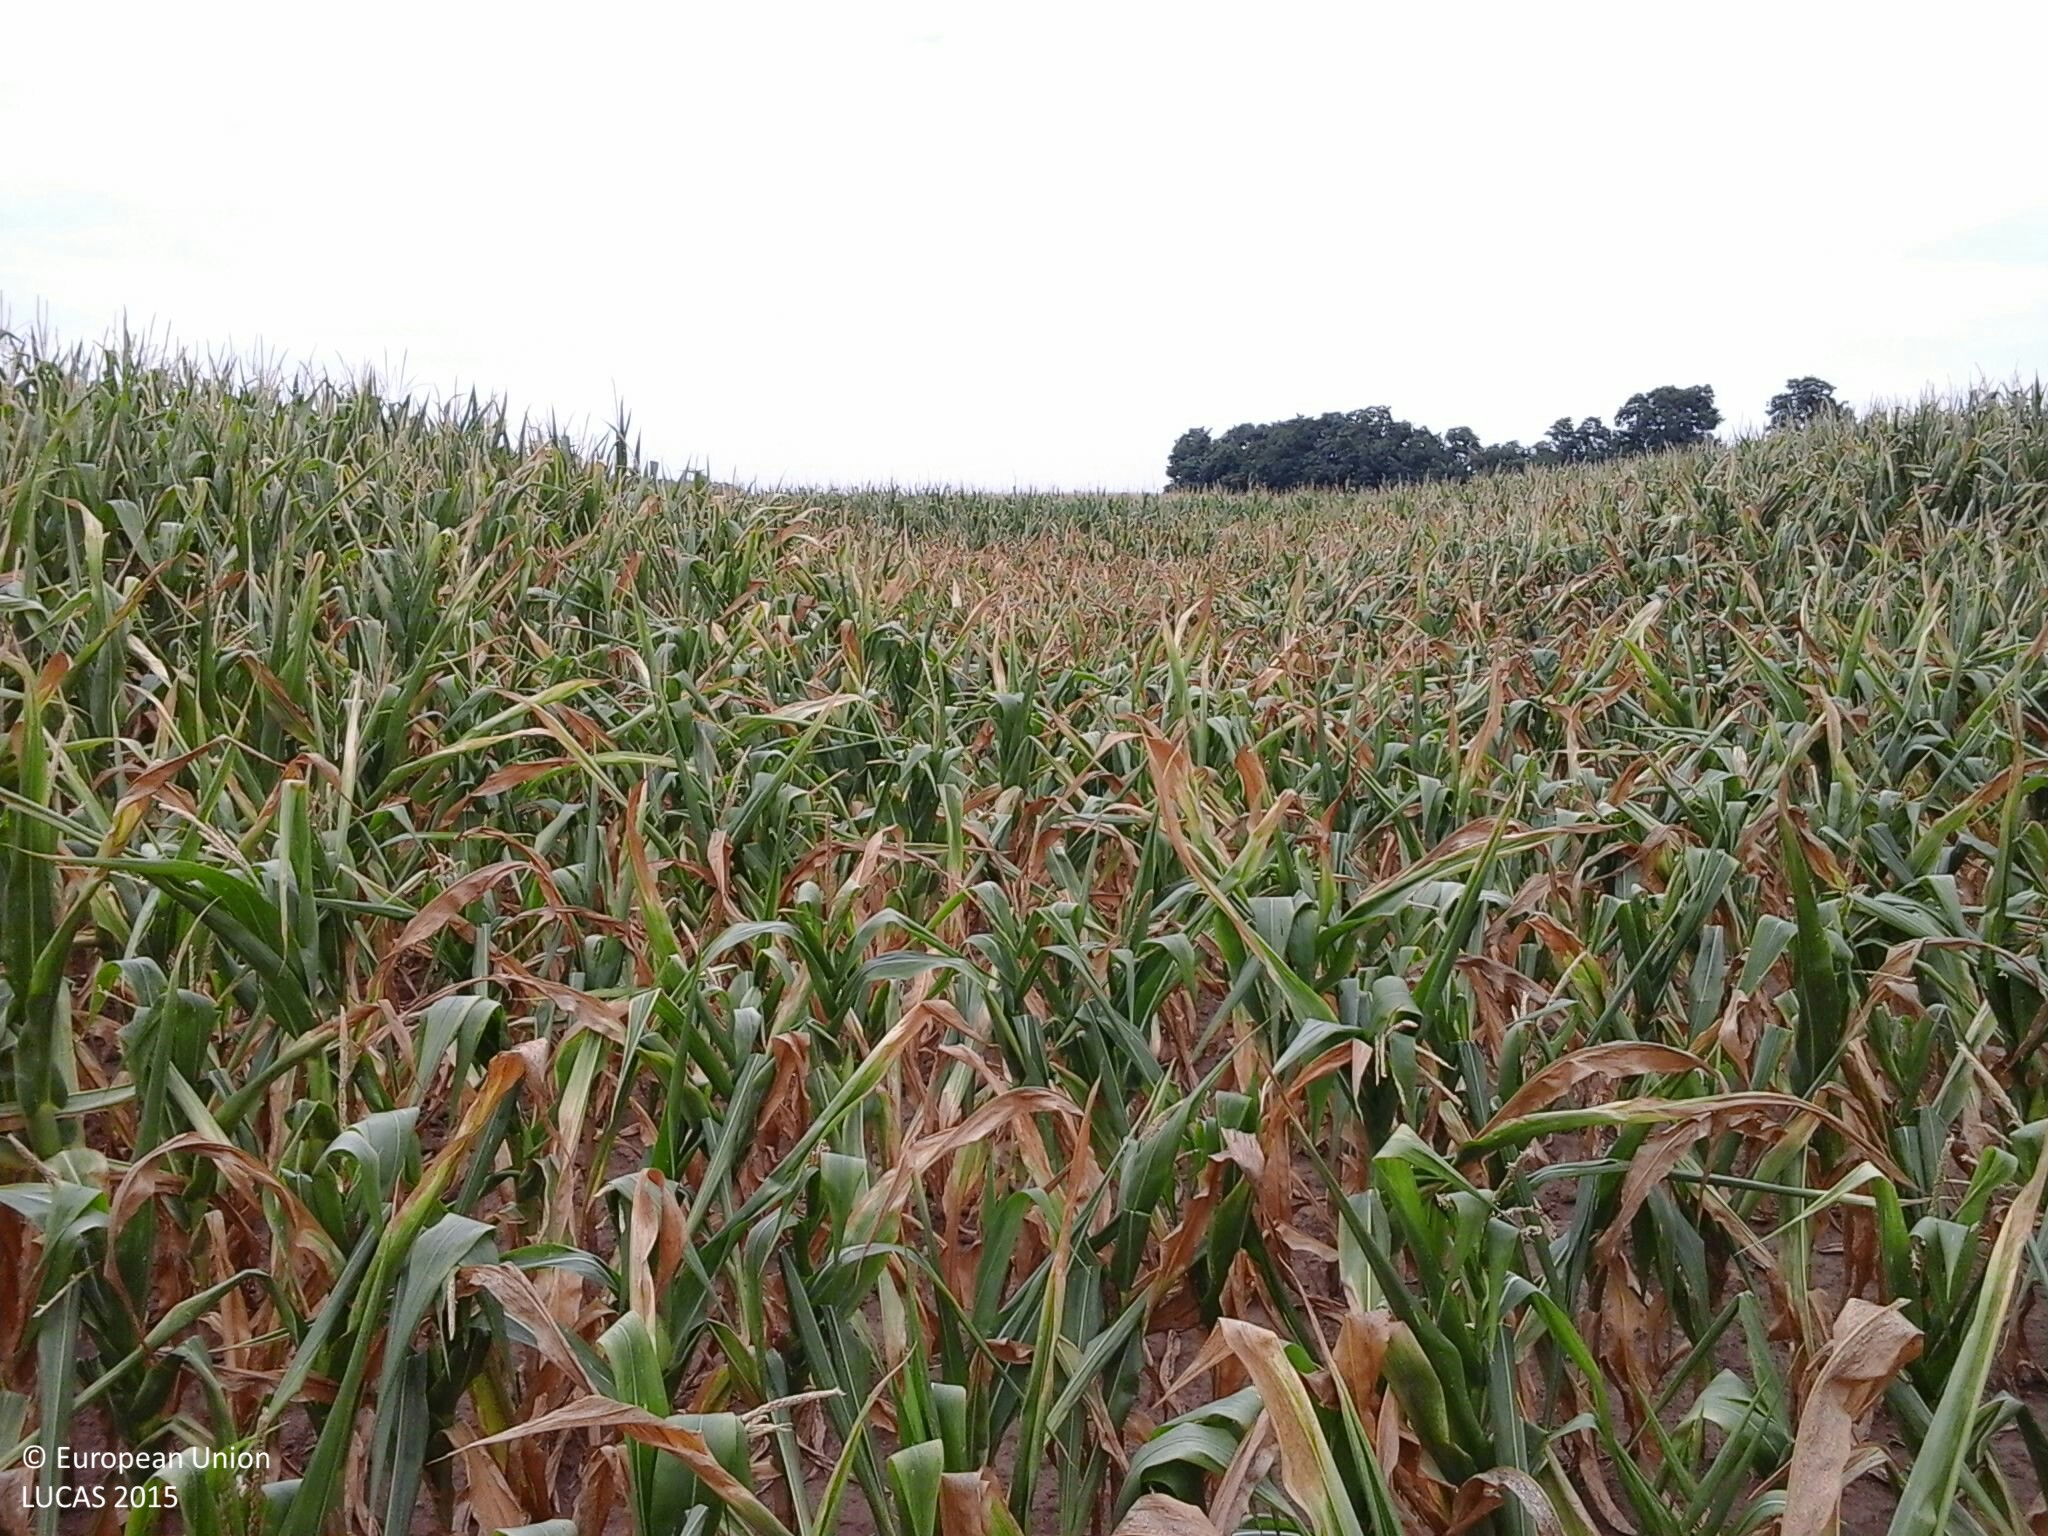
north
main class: Cropland
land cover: Maize
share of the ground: > 75 %
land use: Agriculture (excluding fallow land and kitchen gardens)
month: July
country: HU
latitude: 47.8792
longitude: 21.4498
